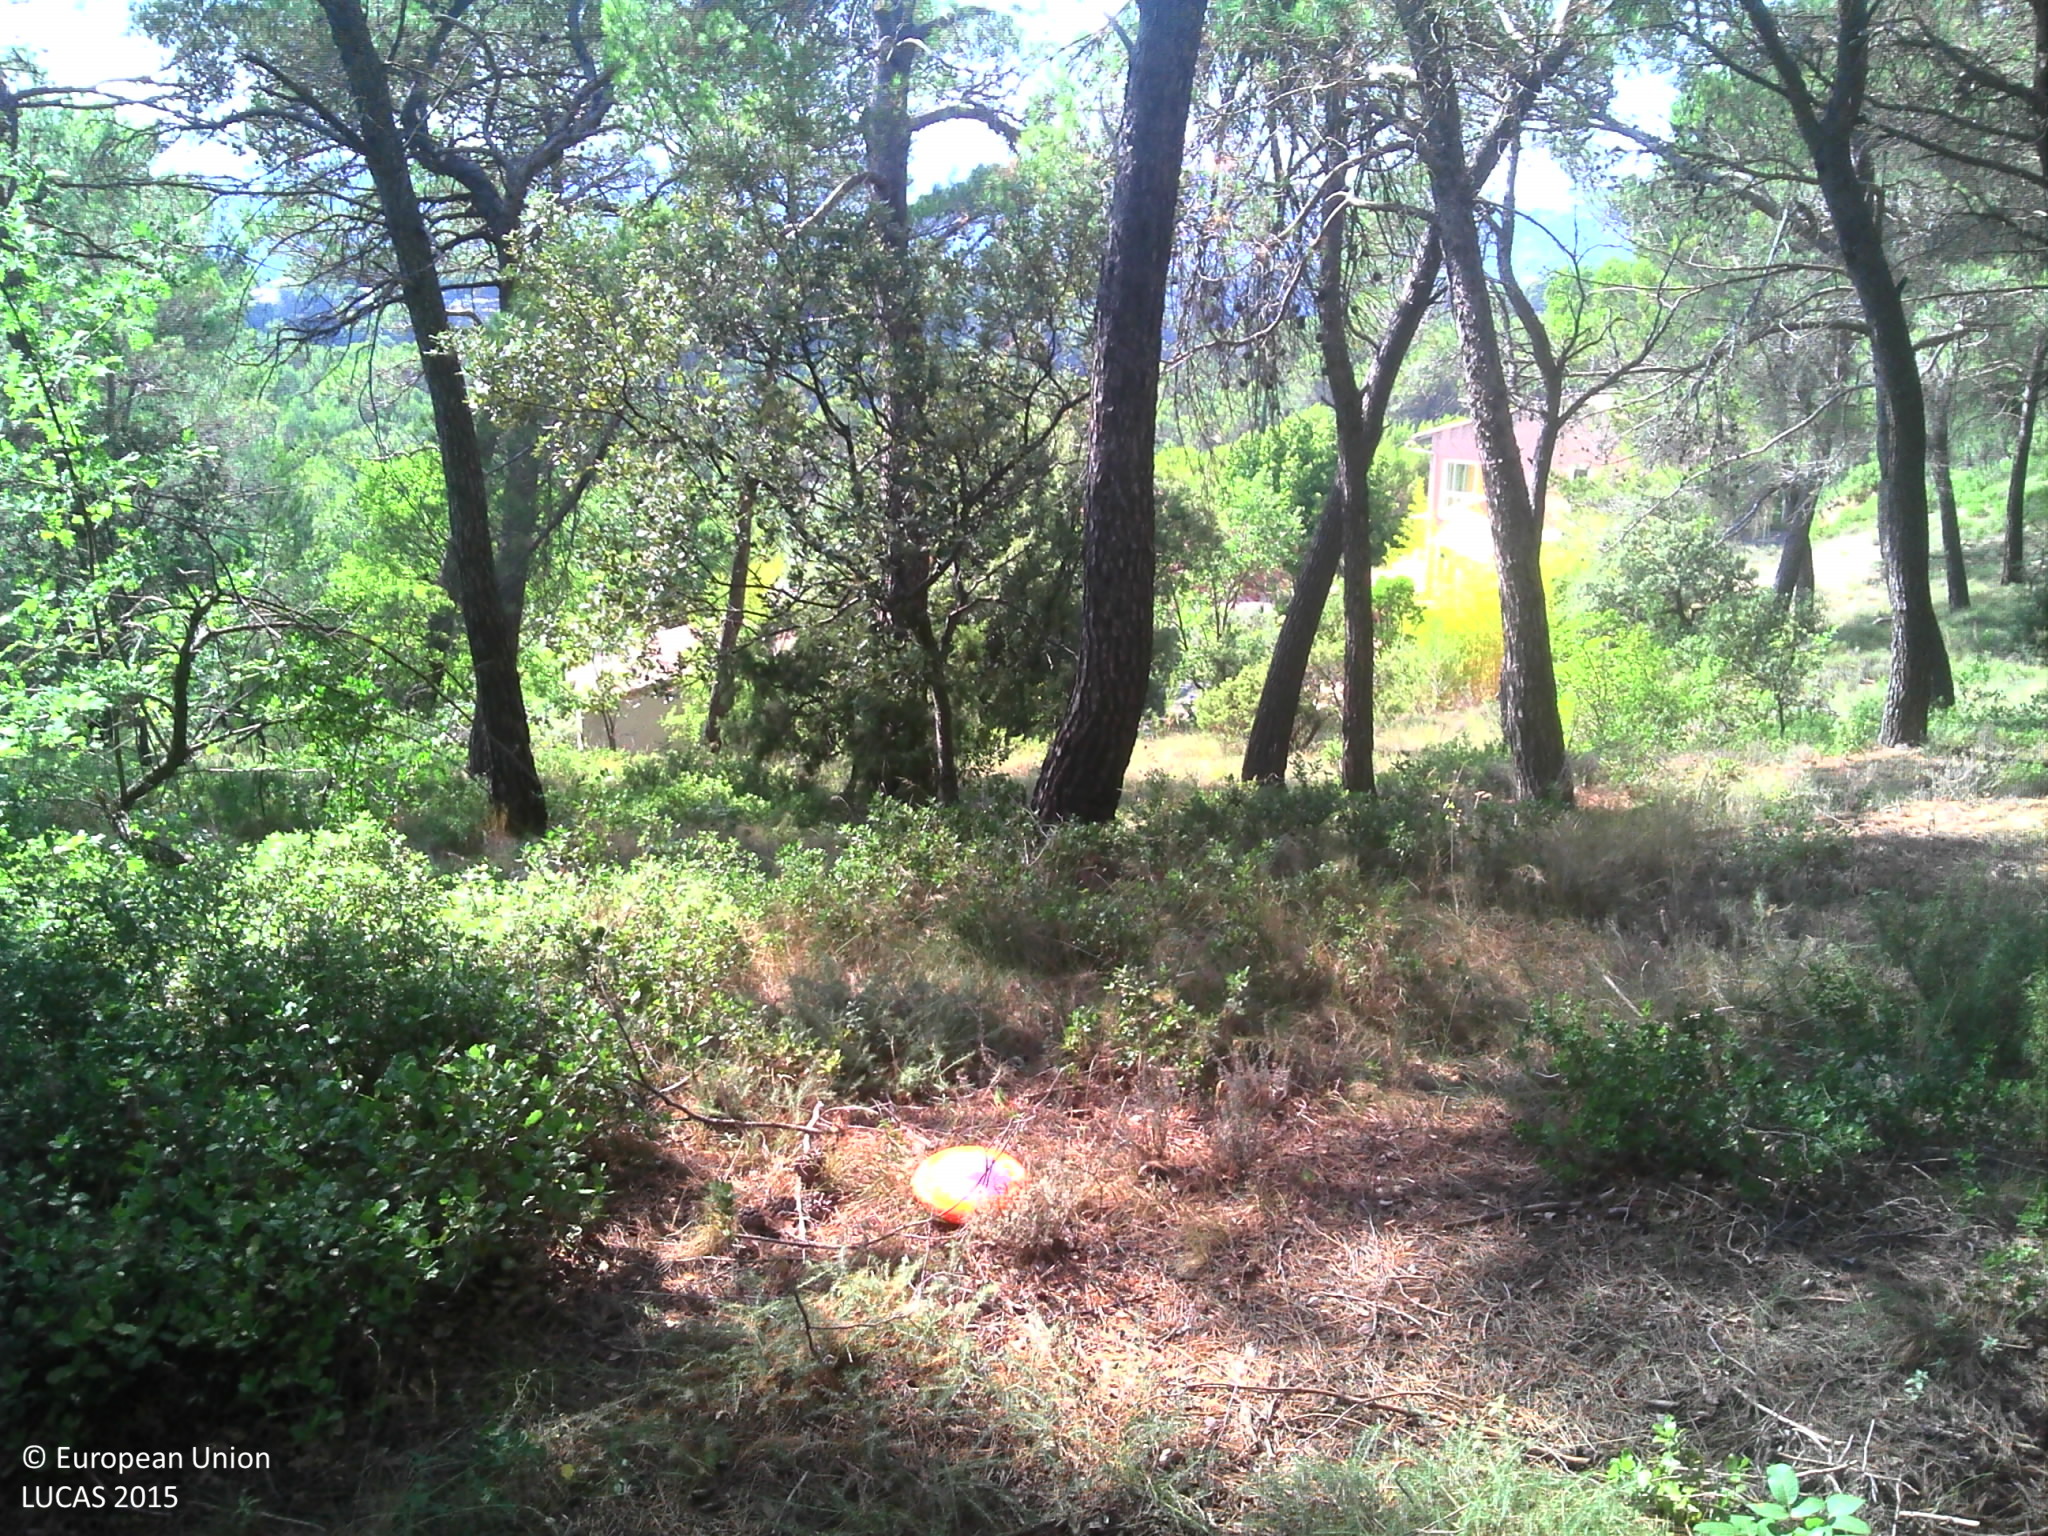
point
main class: Woodland
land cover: Pine dominated coniferous woodland
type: coniferous forest of the mediterranean region
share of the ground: > 75 %
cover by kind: coniferous forest trees 60 %, broadleaved forest trees 15 %, shrubs 10 %, herbaceous plants 10 %, consolidated bare surface 5 %
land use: Forestry
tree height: > 5 m
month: July
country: FR
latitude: 43.6686
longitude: 5.3585
